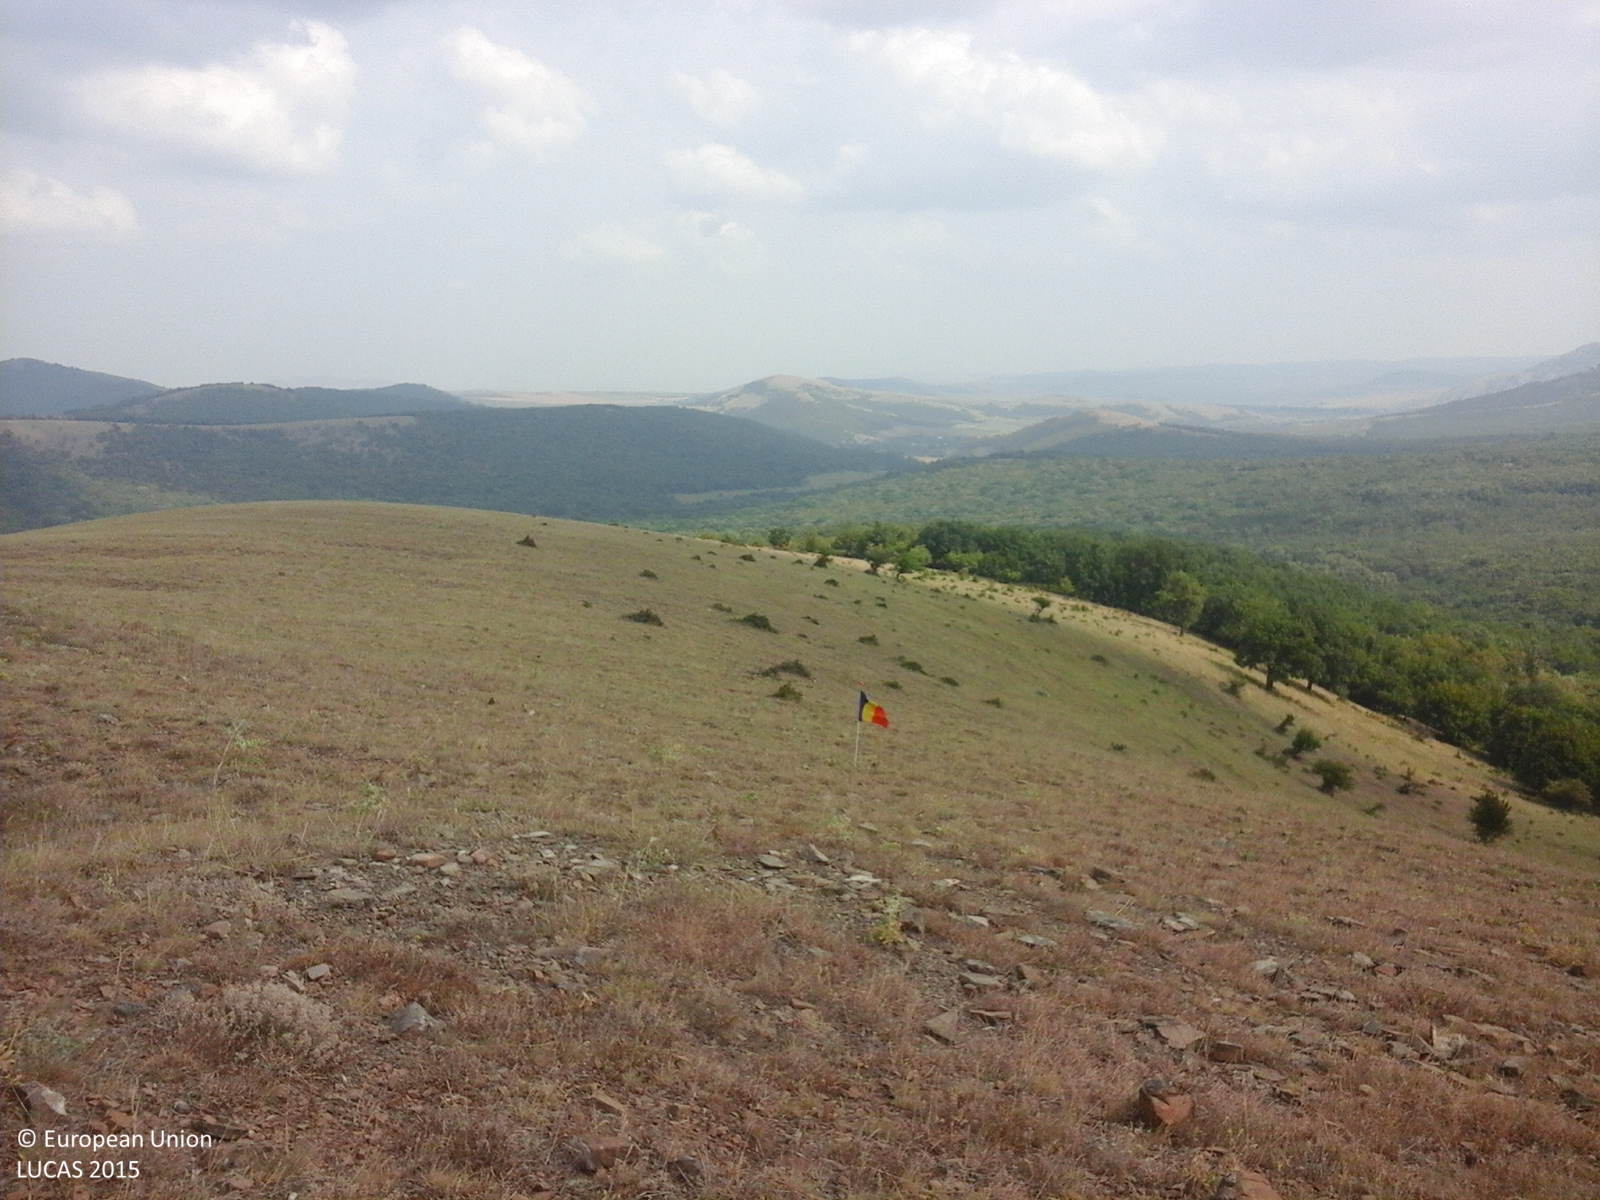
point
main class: Grassland
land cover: Grassland without tree/shrub cover
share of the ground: > 75 %
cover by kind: herbaceous plants 80 %, unconsolidated bare surface 20 %
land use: Agriculture (excluding fallow land and kitchen gardens)
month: July
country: RO
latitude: 45.0901
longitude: 28.4893
